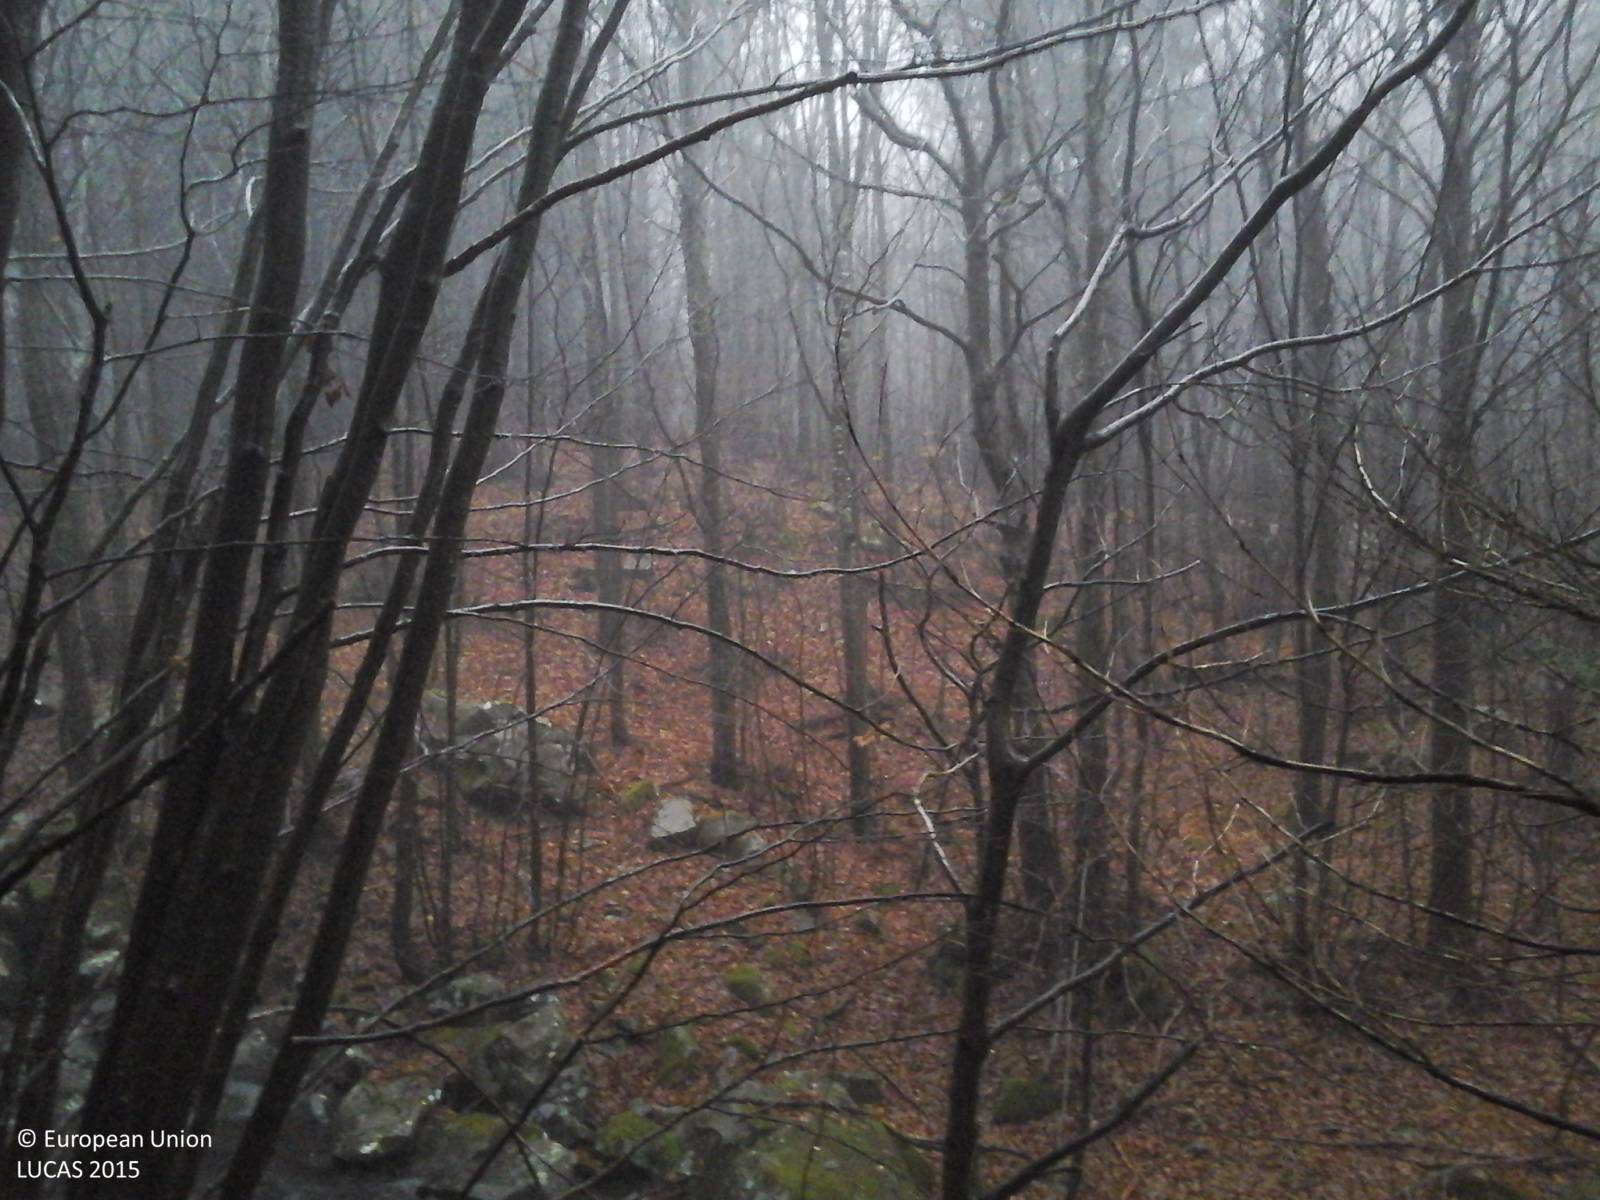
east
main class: Woodland
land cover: Other mixed woodland
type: beech forest
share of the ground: > 75 %
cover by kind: coniferous forest trees 50 %, broadleaved forest trees 50 %
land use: Forestry
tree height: > 5 m
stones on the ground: < 10 %
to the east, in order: Other mixed woodland; Shrubland without tree cover; Electric lines; Shrubland without tree cover; Other mixed woodland
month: January
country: IT
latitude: 44.2962
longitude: 10.2126
